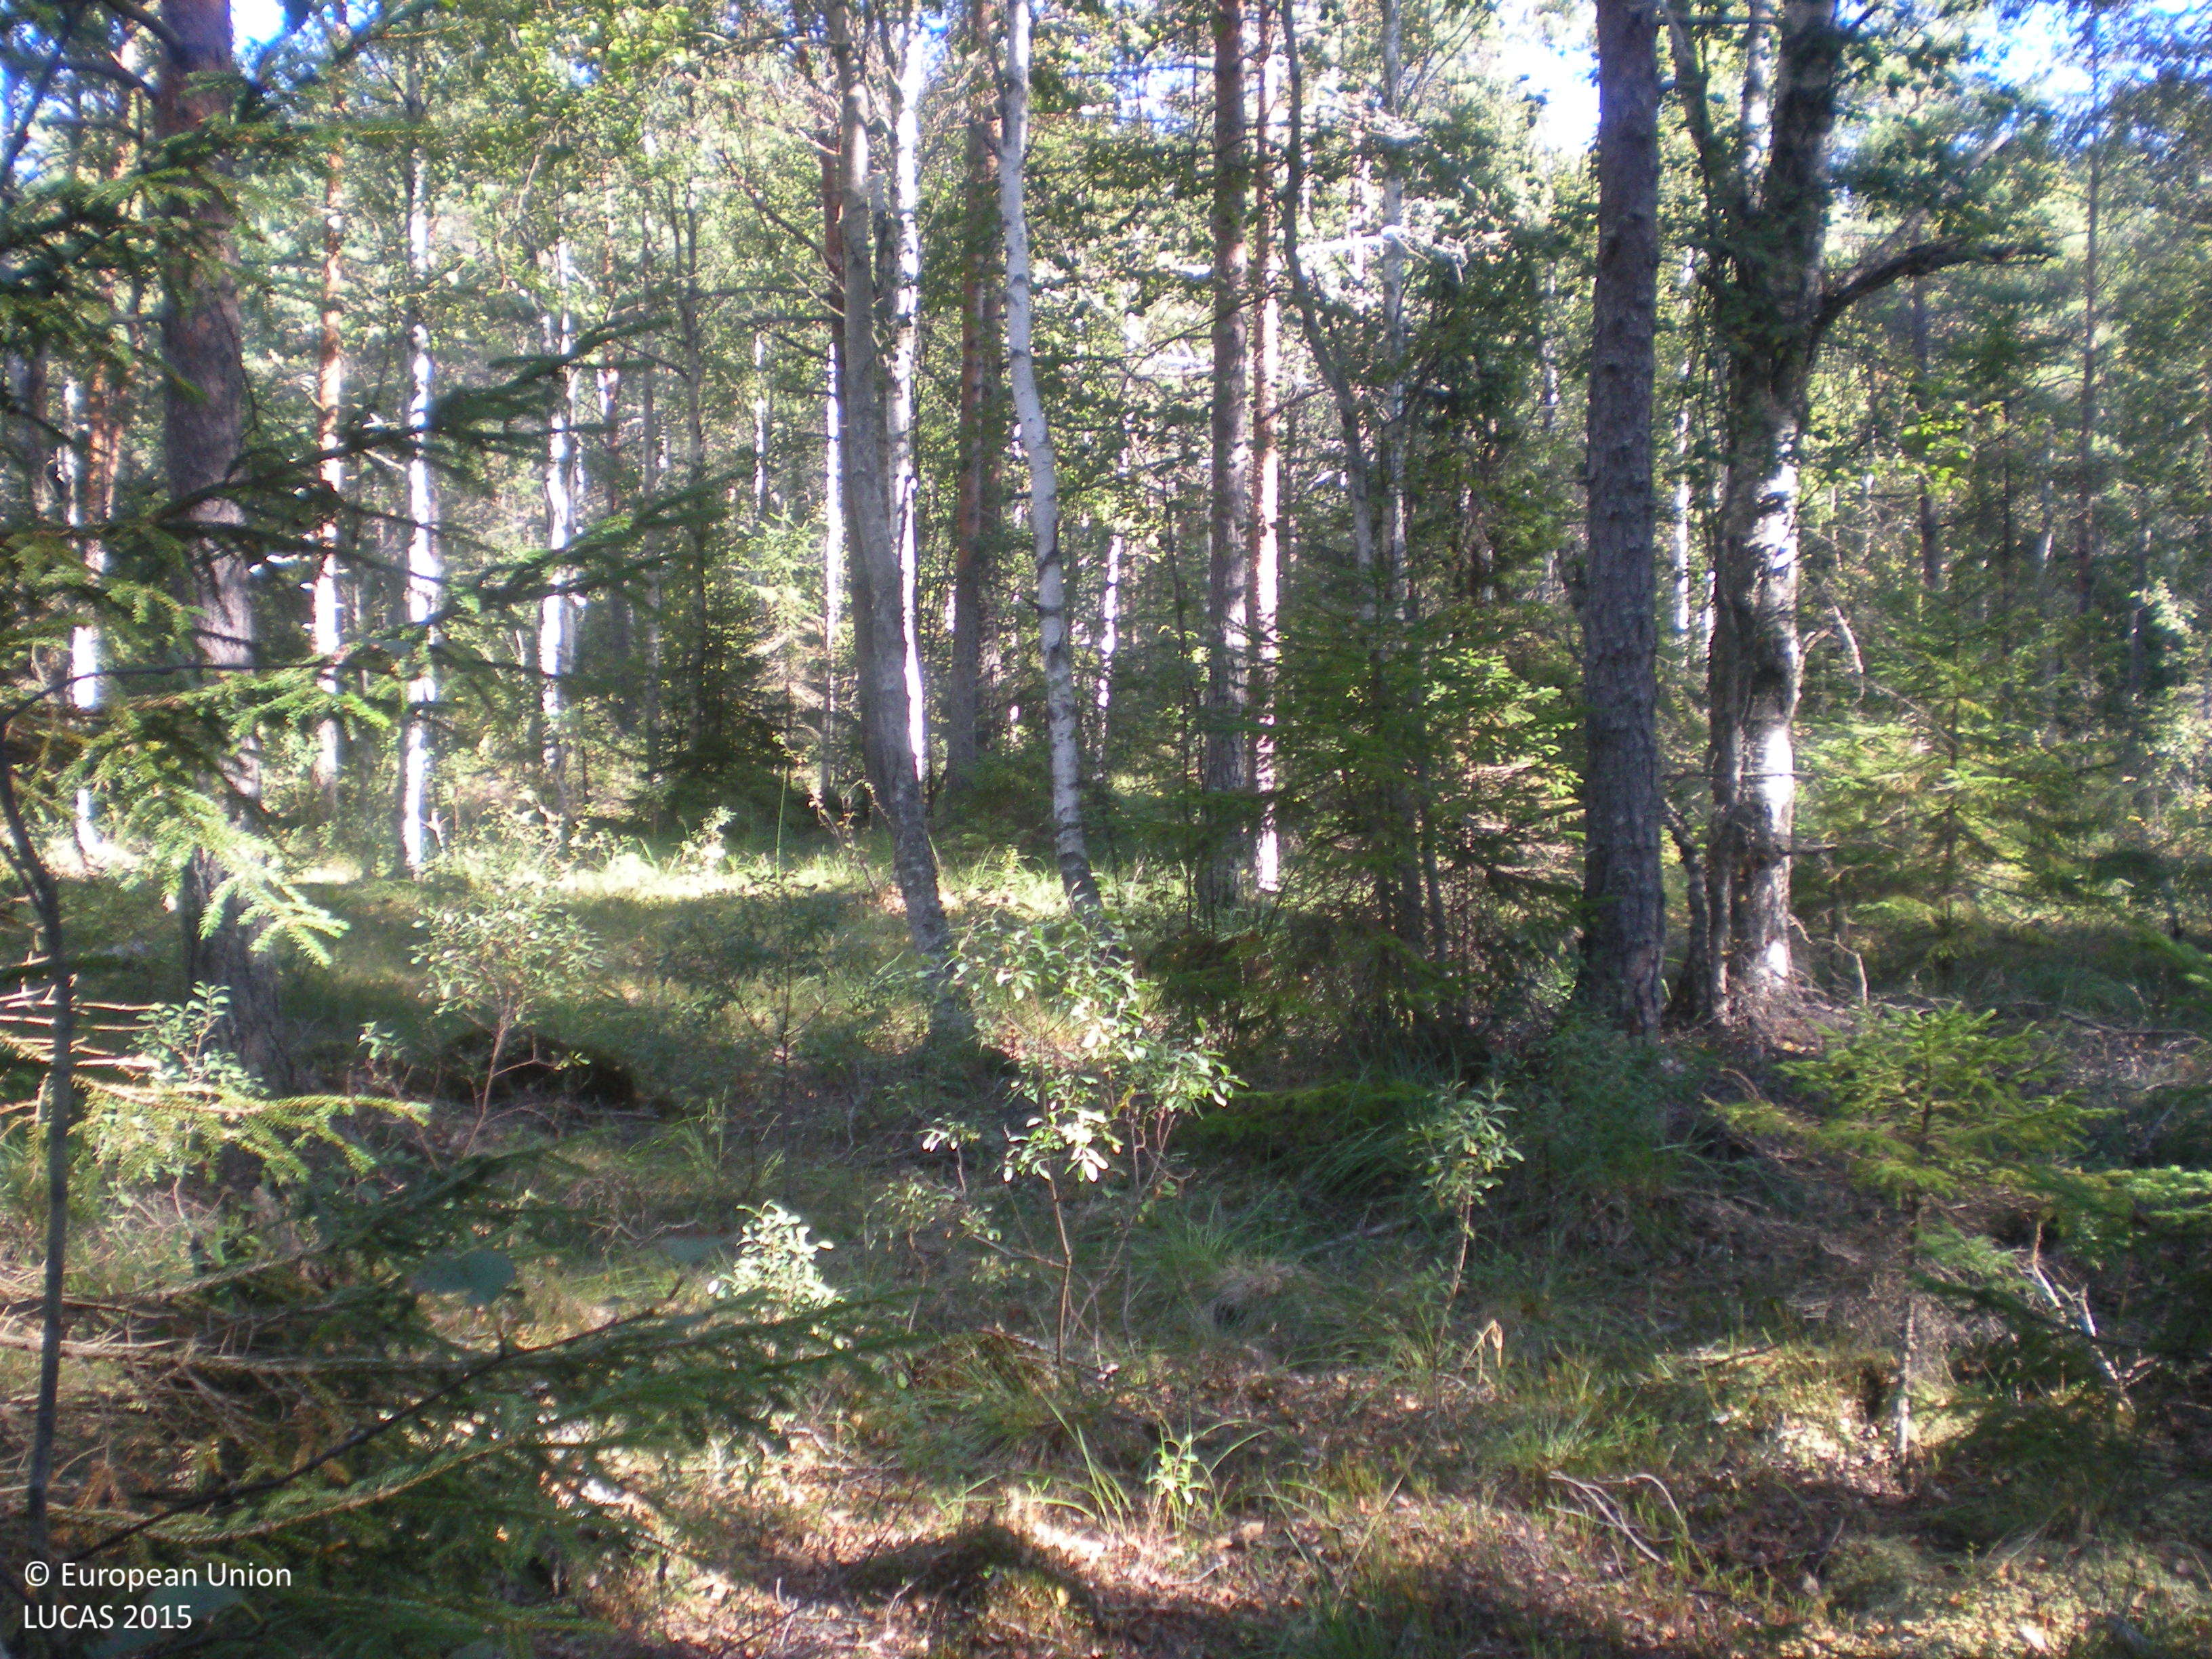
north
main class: Woodland
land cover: Pine dominated mixed woodland
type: boreal forest
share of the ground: 50 - 75 %
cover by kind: coniferous forest trees 40 %, broadleaved forest trees 25 %, herbaceous plants 15 %, lichens and mosses 10 %, shrubs 5 %
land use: Forestry
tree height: > 5 m
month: August
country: SE
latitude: 60.5775
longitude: 17.1614
